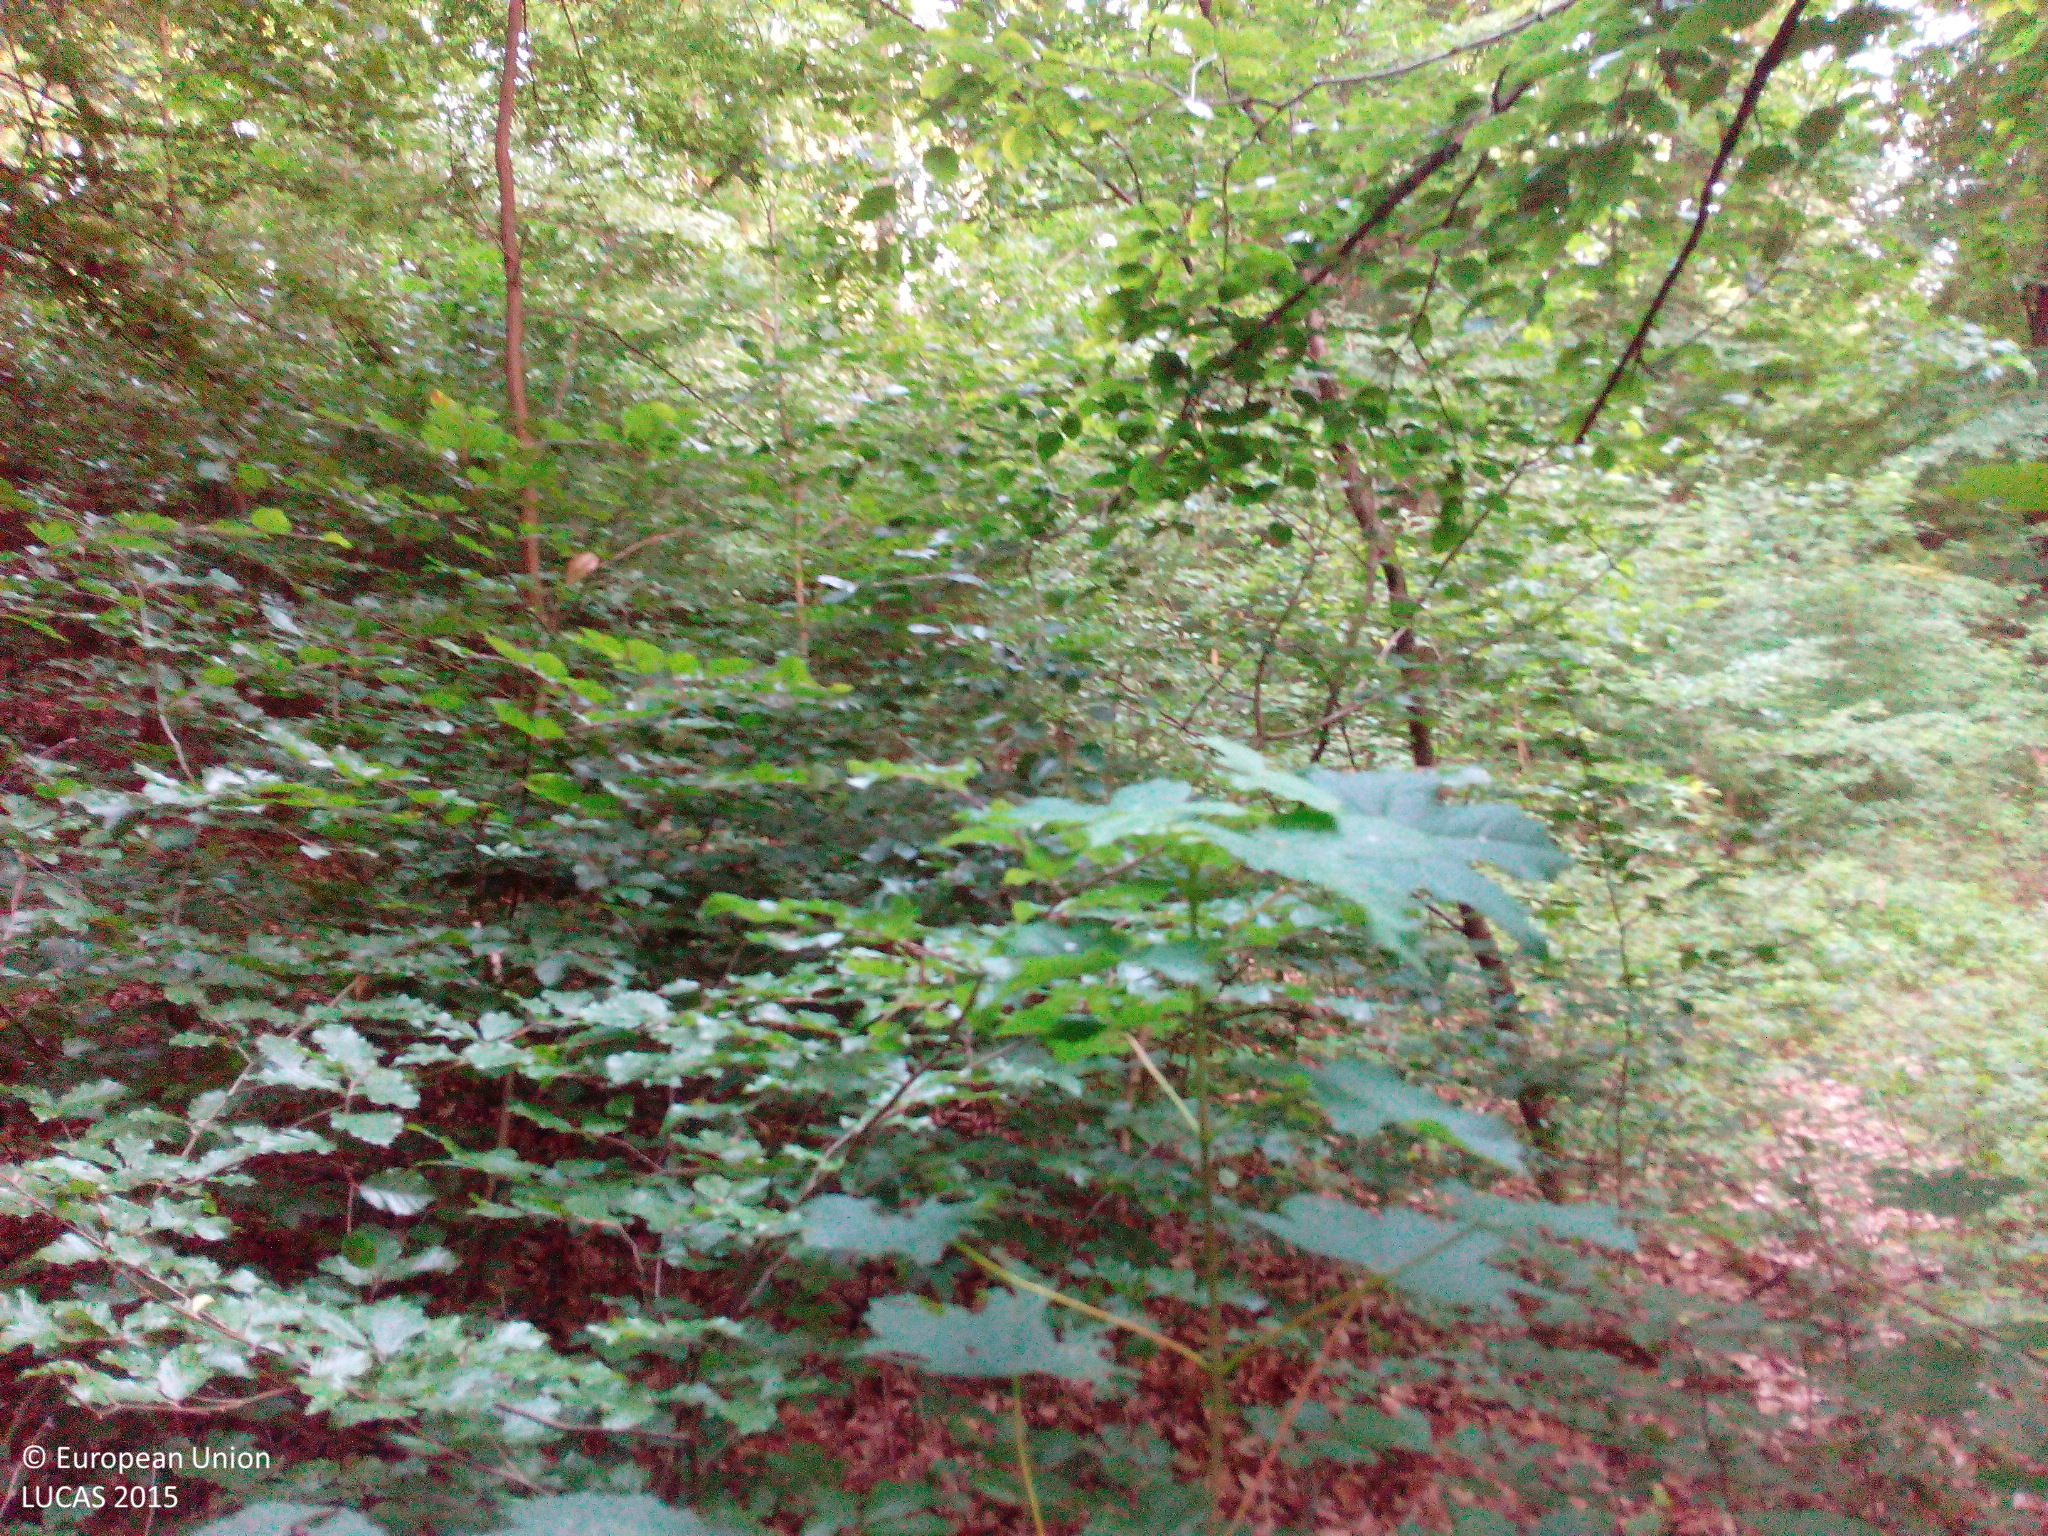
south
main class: Woodland
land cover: Broadleaved woodland
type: mesophytic deciduous forest
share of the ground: > 75 %
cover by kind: broadleaved forest trees 95 %, unconsolidated bare surface 5 %
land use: Forestry
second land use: Amenities, museums, leisure
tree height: > 5 m
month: June
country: DE
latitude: 52.1193
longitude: 12.4094
